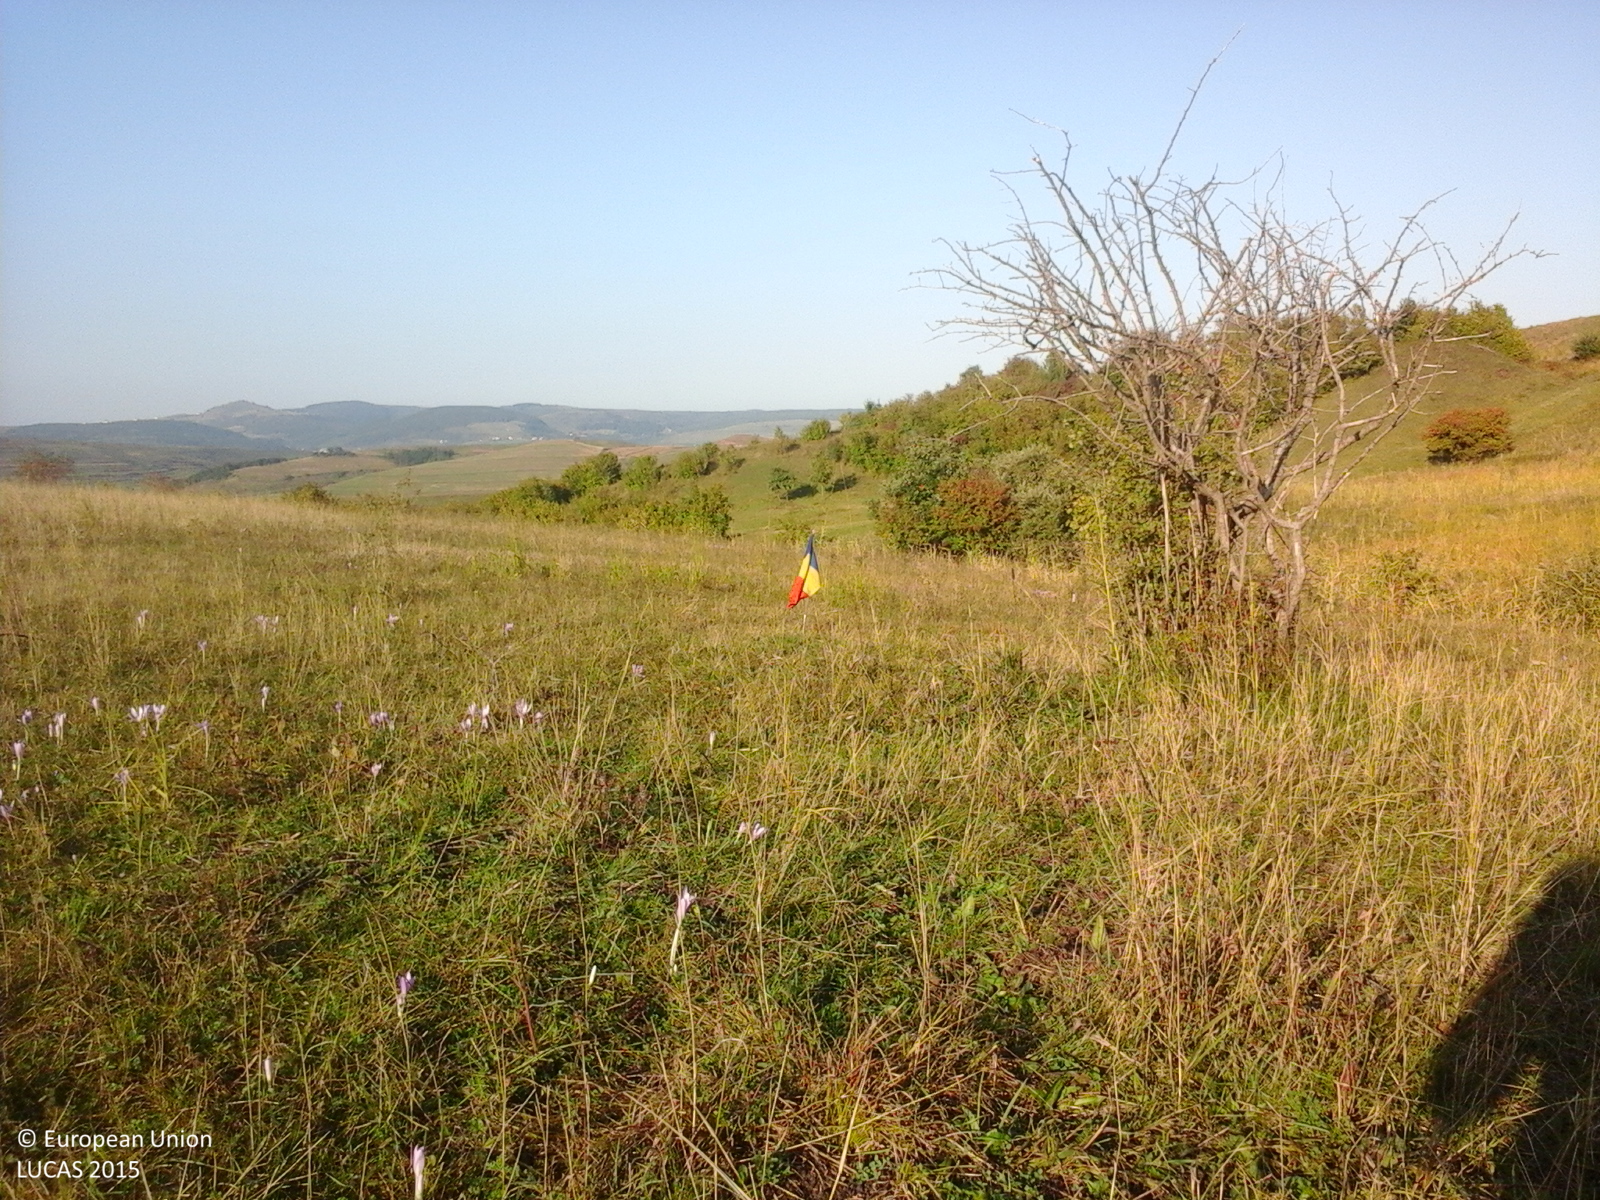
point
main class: Grassland
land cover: Grassland with sparse tree/shrub cover
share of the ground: > 75 %
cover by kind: herbaceous plants 85 %, shrubs 10 %, broadleaved forest trees 5 %
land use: Agriculture (excluding fallow land and kitchen gardens)
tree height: < 5 m
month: October
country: RO
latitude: 46.6036
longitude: 23.5021
